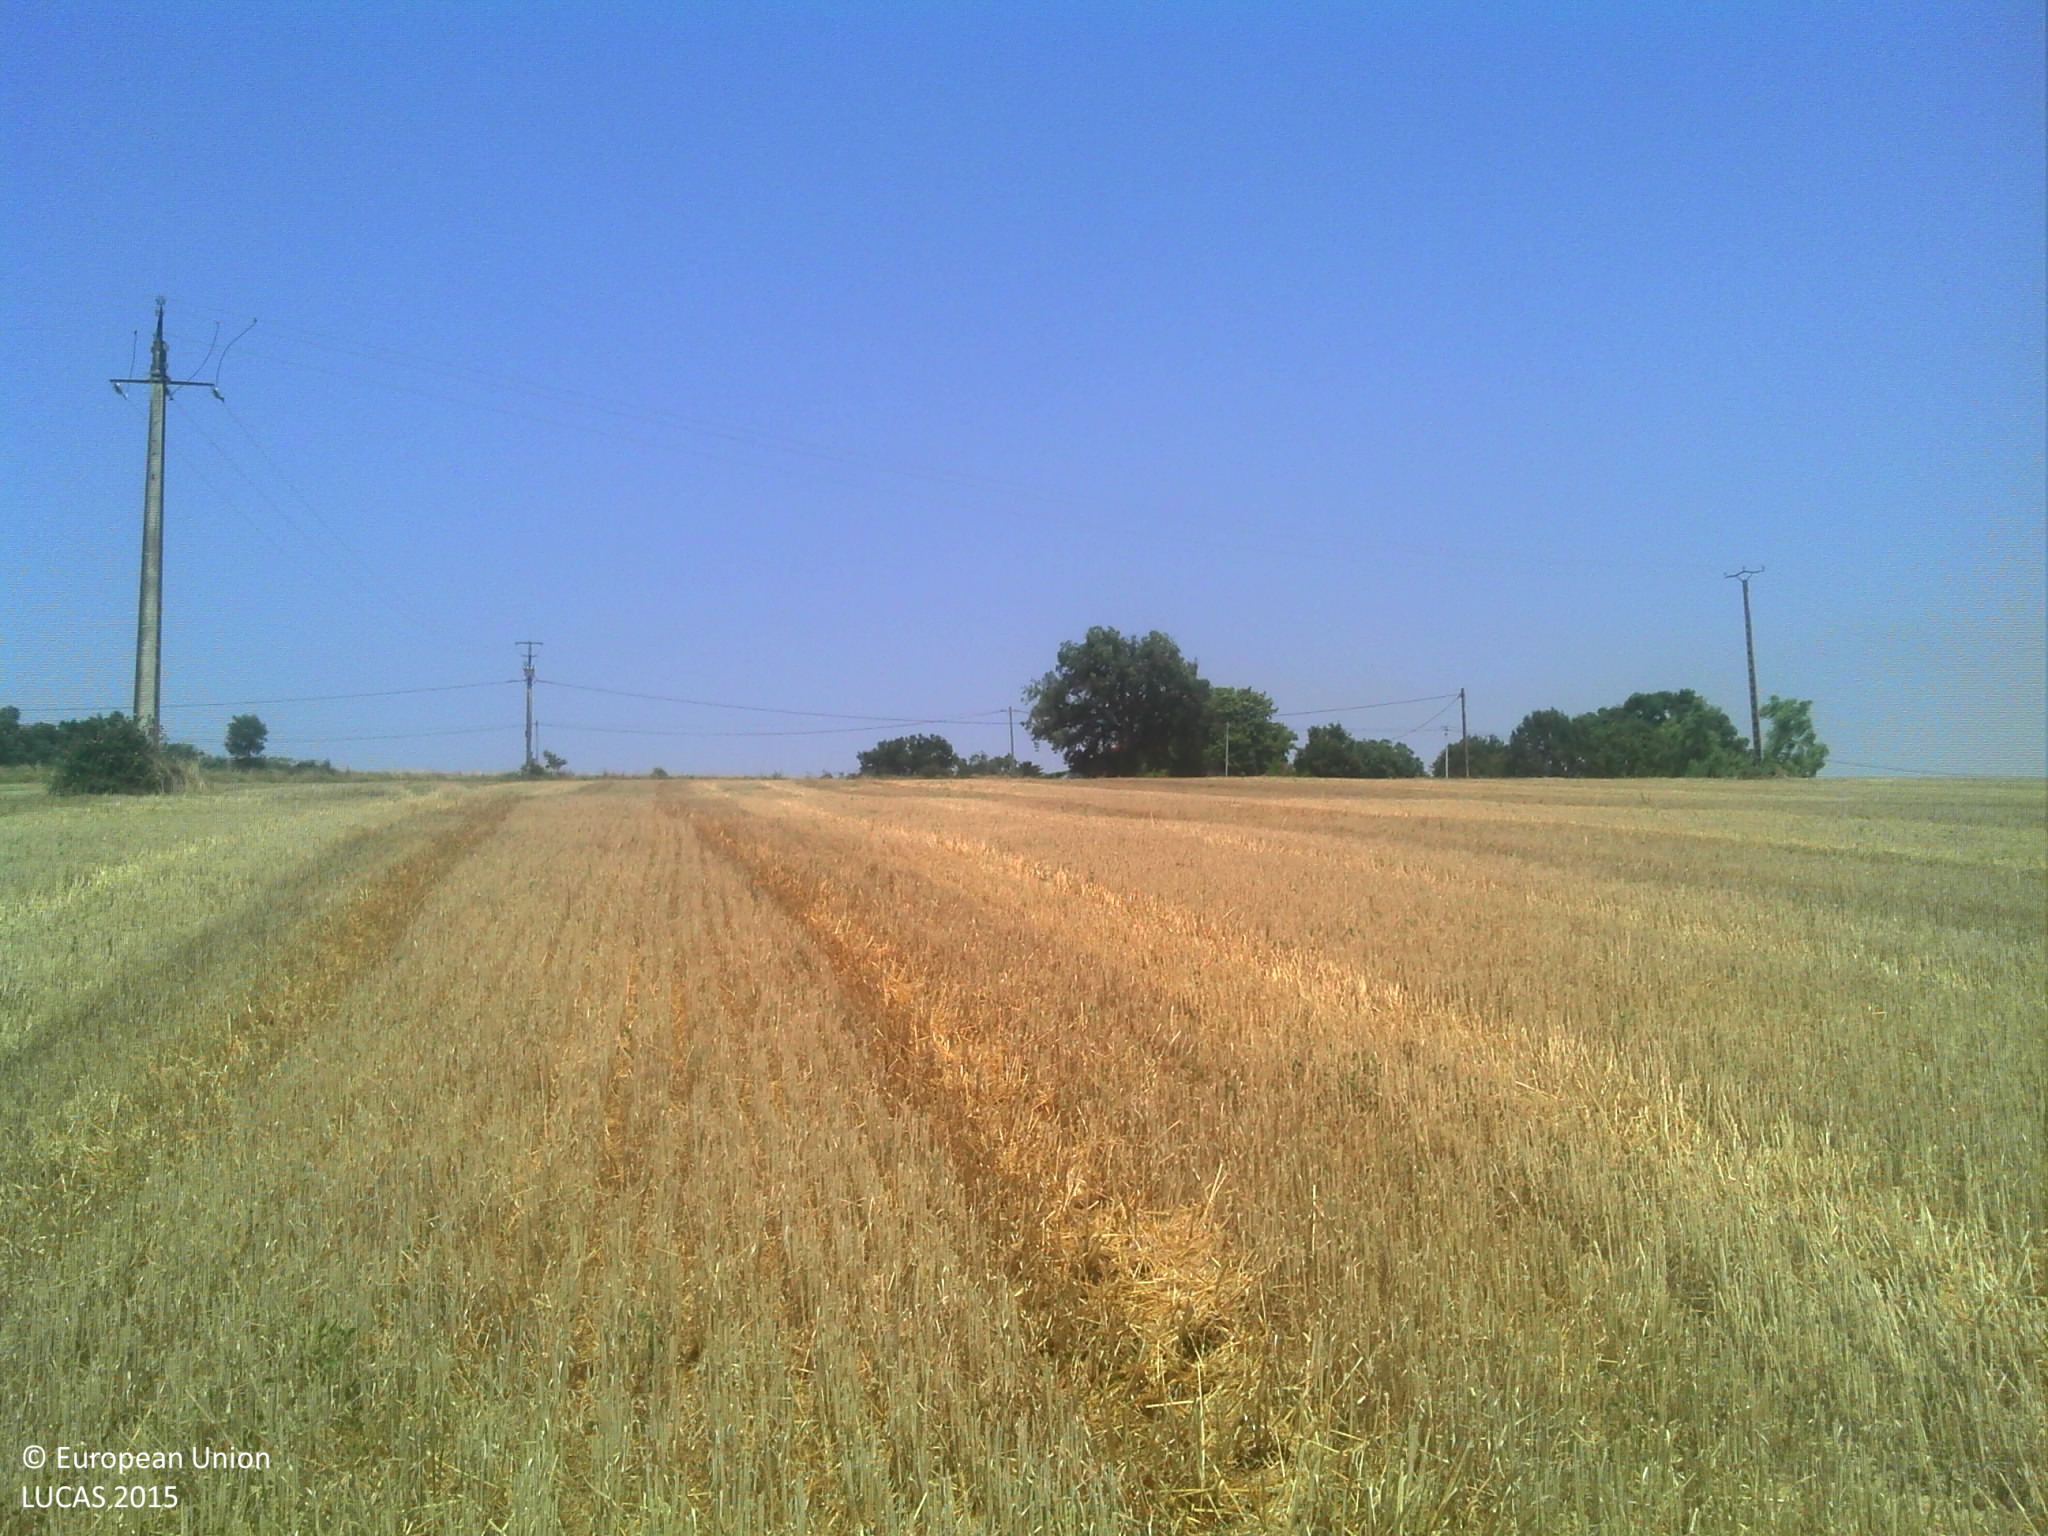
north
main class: Cropland
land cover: Common wheat
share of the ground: > 75 %
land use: Agriculture (excluding fallow land and kitchen gardens)
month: July
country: FR
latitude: 43.3671
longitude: 1.0800
